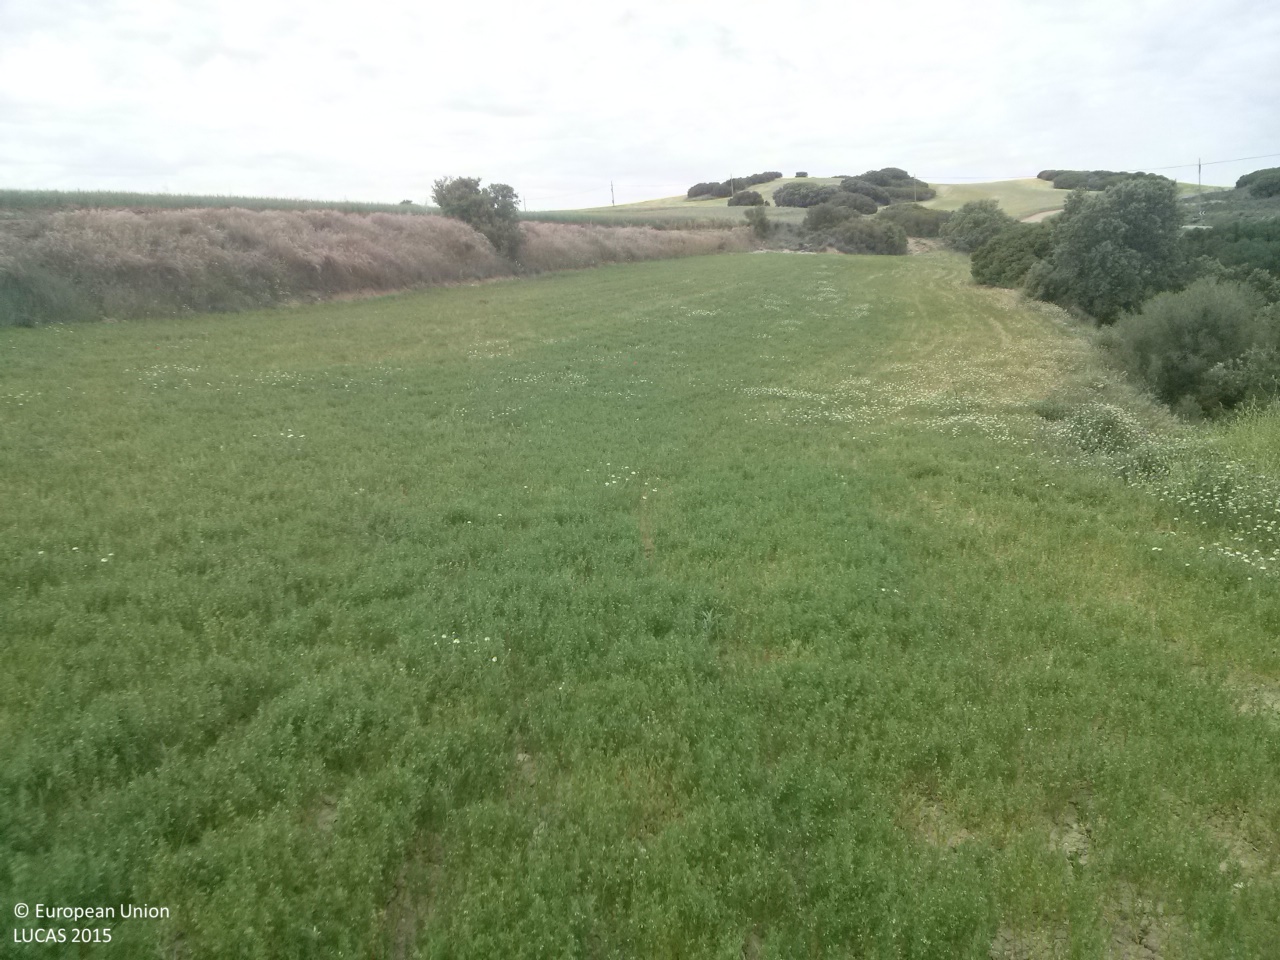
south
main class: Cropland
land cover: Dry pulses
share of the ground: > 75 %
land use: Agriculture (excluding fallow land and kitchen gardens)
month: May
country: ES
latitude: 40.1079
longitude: -2.8935
